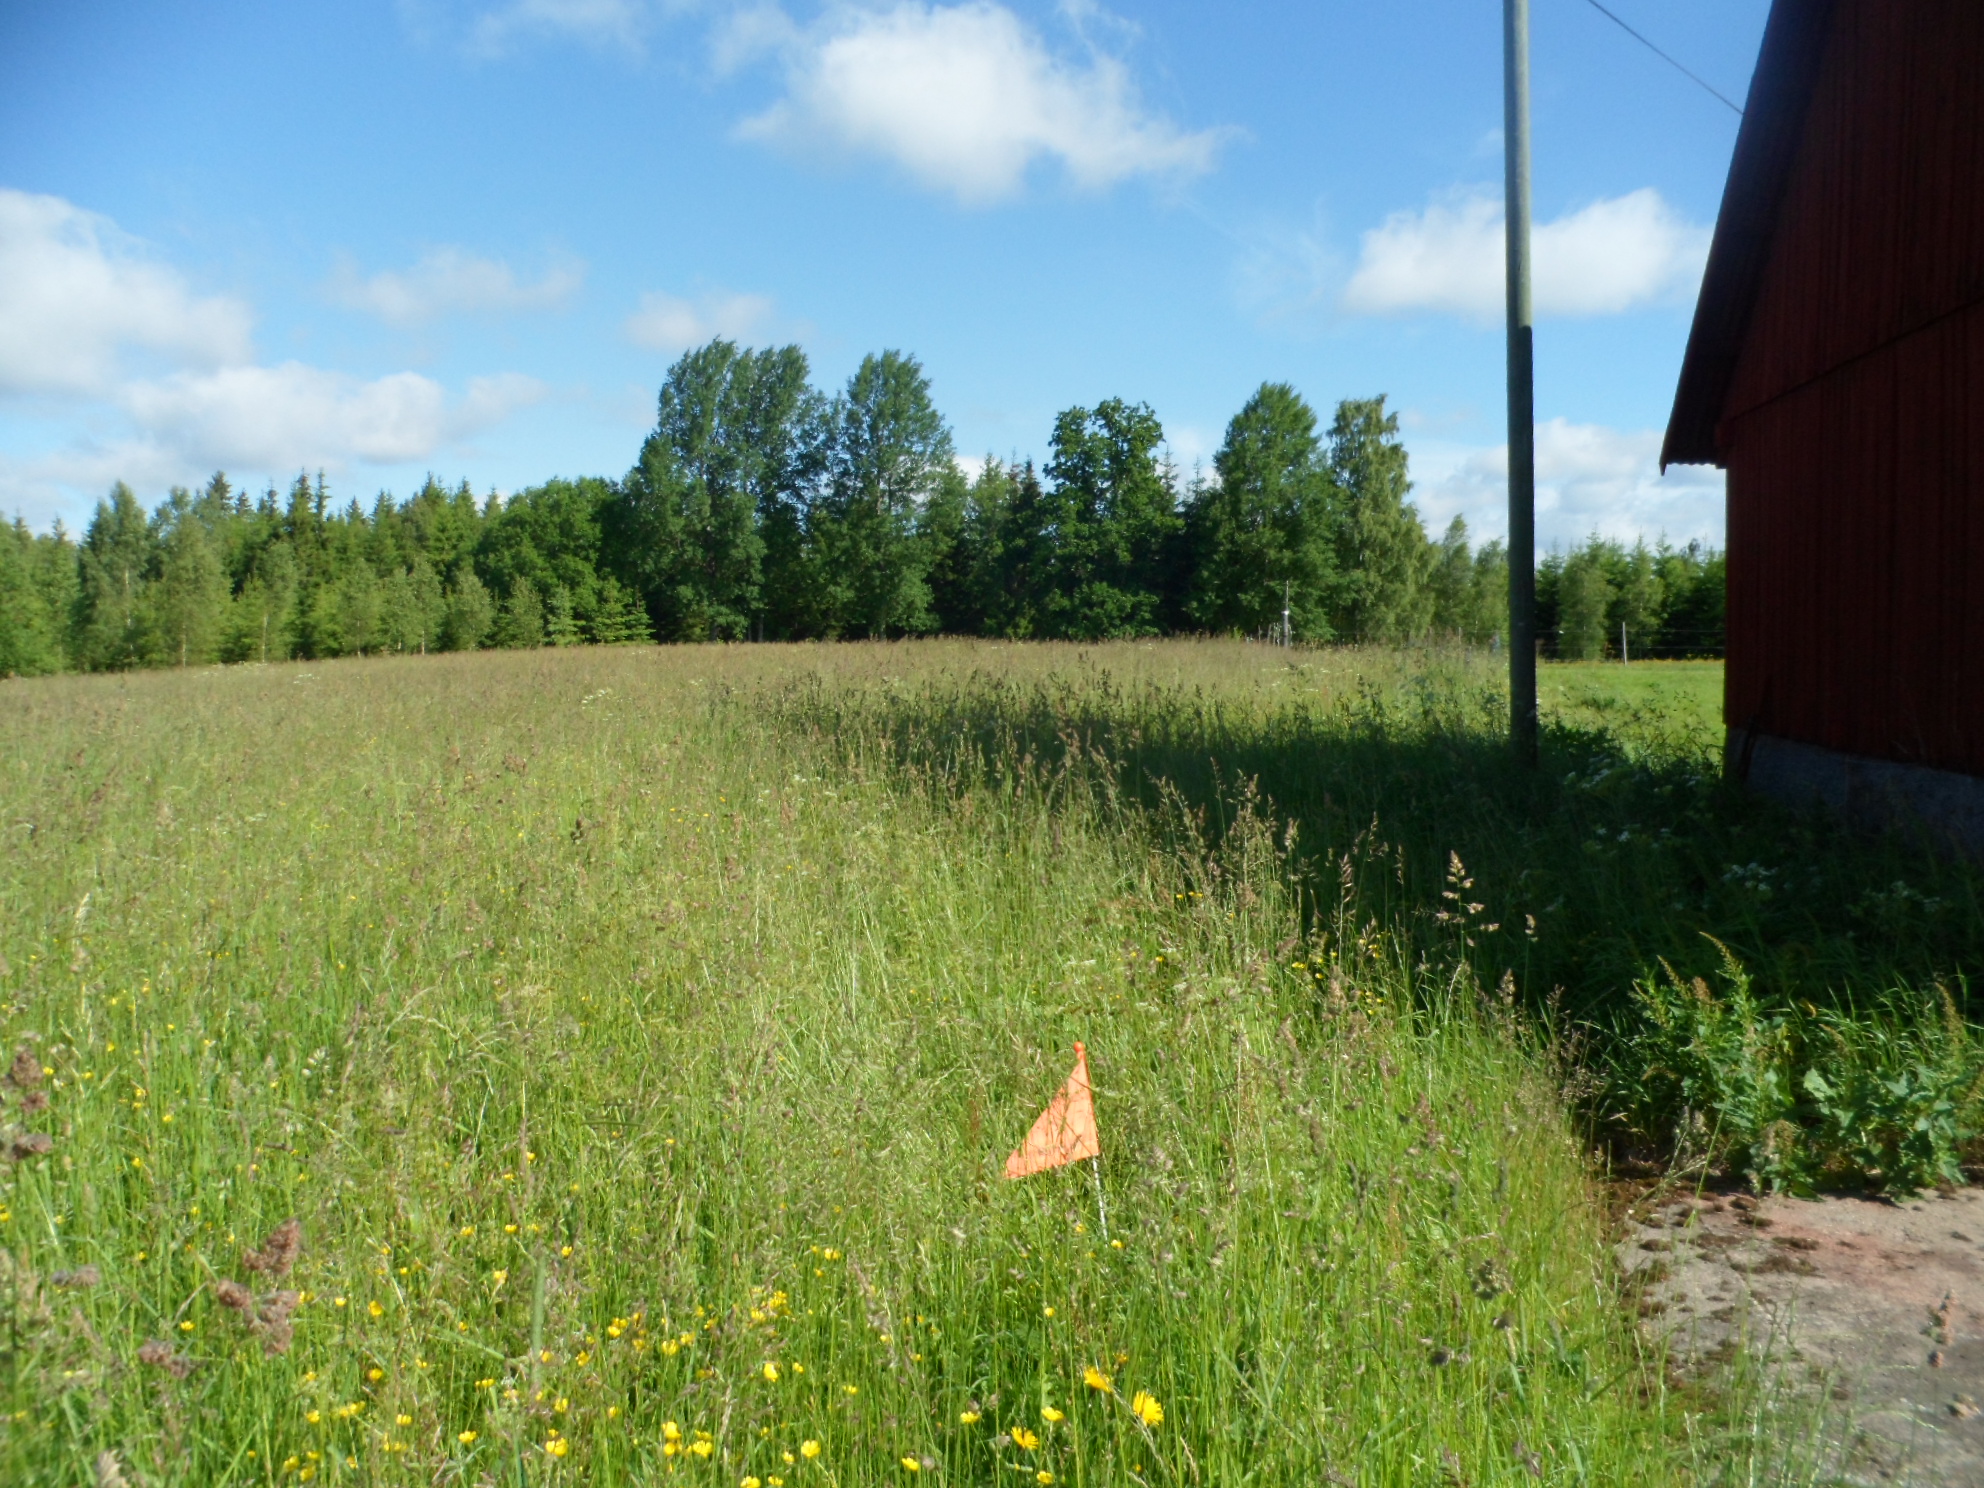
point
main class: Grassland
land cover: Grassland without tree/shrub cover
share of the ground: > 75 %
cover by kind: herbaceous plants 100 %
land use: Agriculture (excluding fallow land and kitchen gardens)
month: June
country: SE
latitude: 57.1223
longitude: 14.8692
